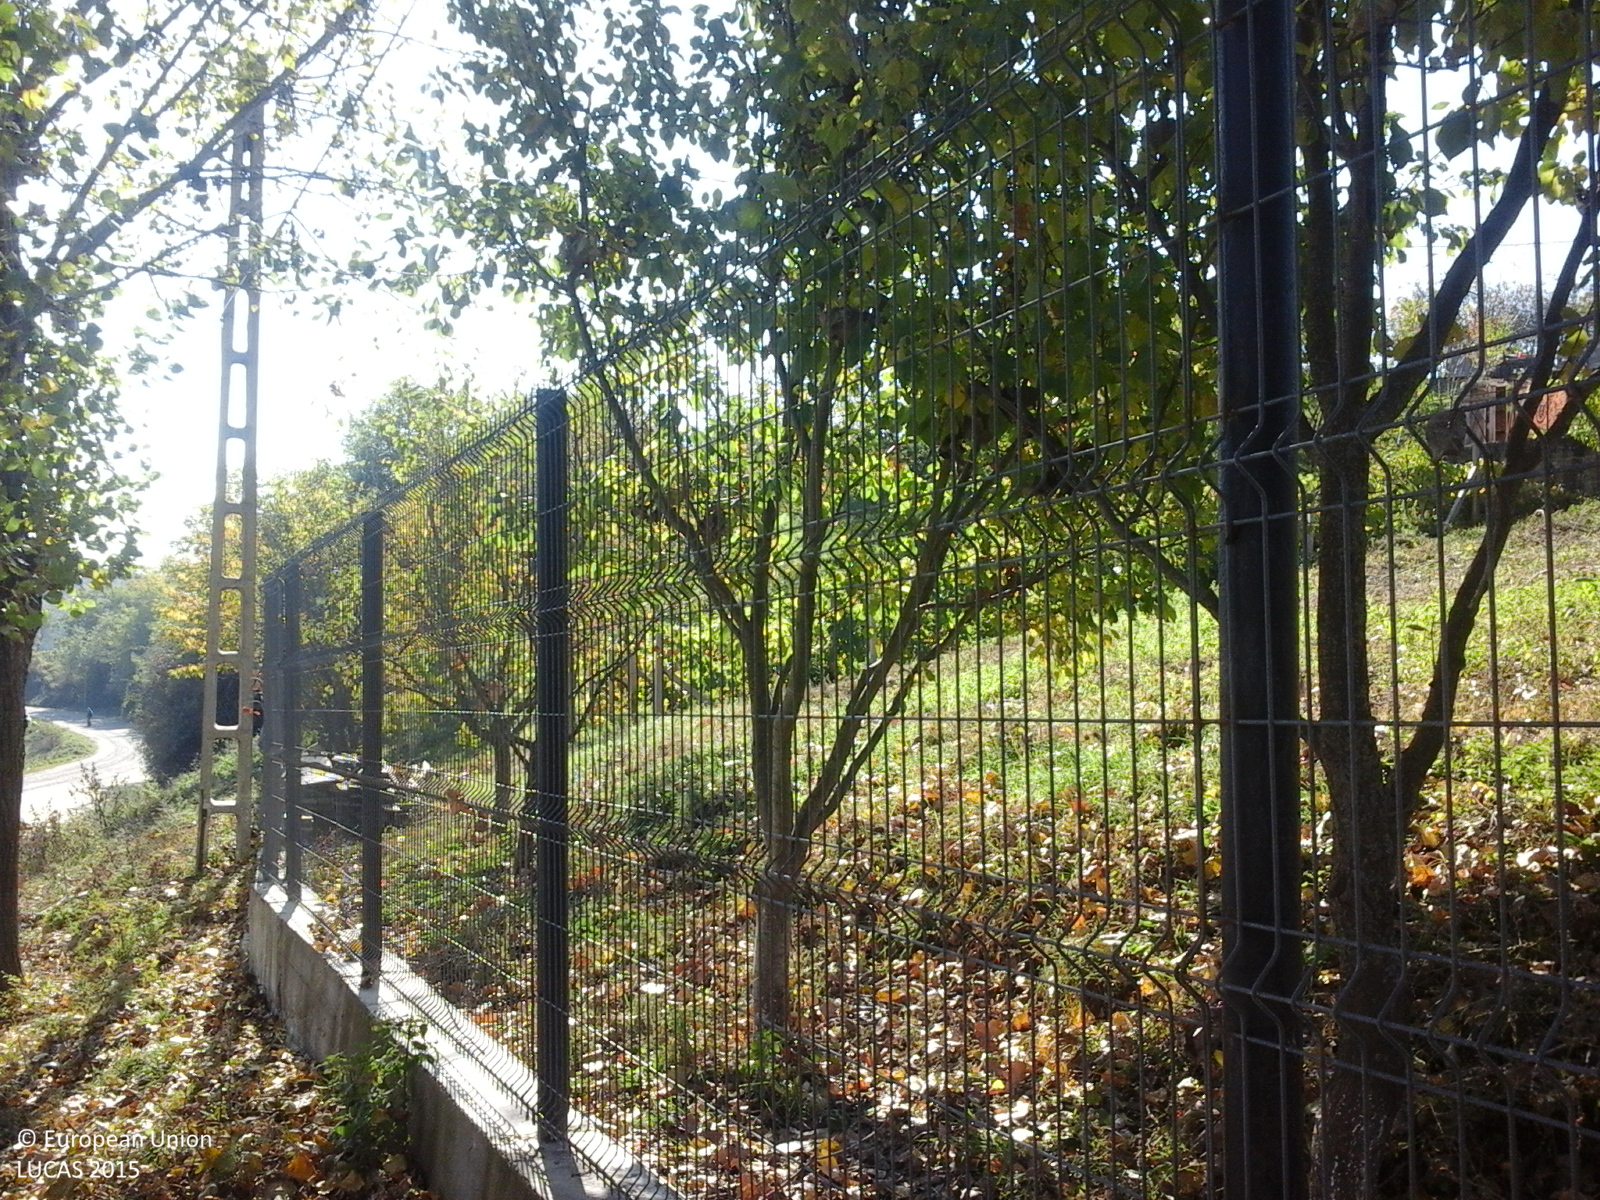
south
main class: Grassland
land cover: Grassland without tree/shrub cover
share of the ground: > 75 %
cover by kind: herbaceous plants 100 %
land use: Residential
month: October
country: RO
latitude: 45.4223
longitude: 26.5222
